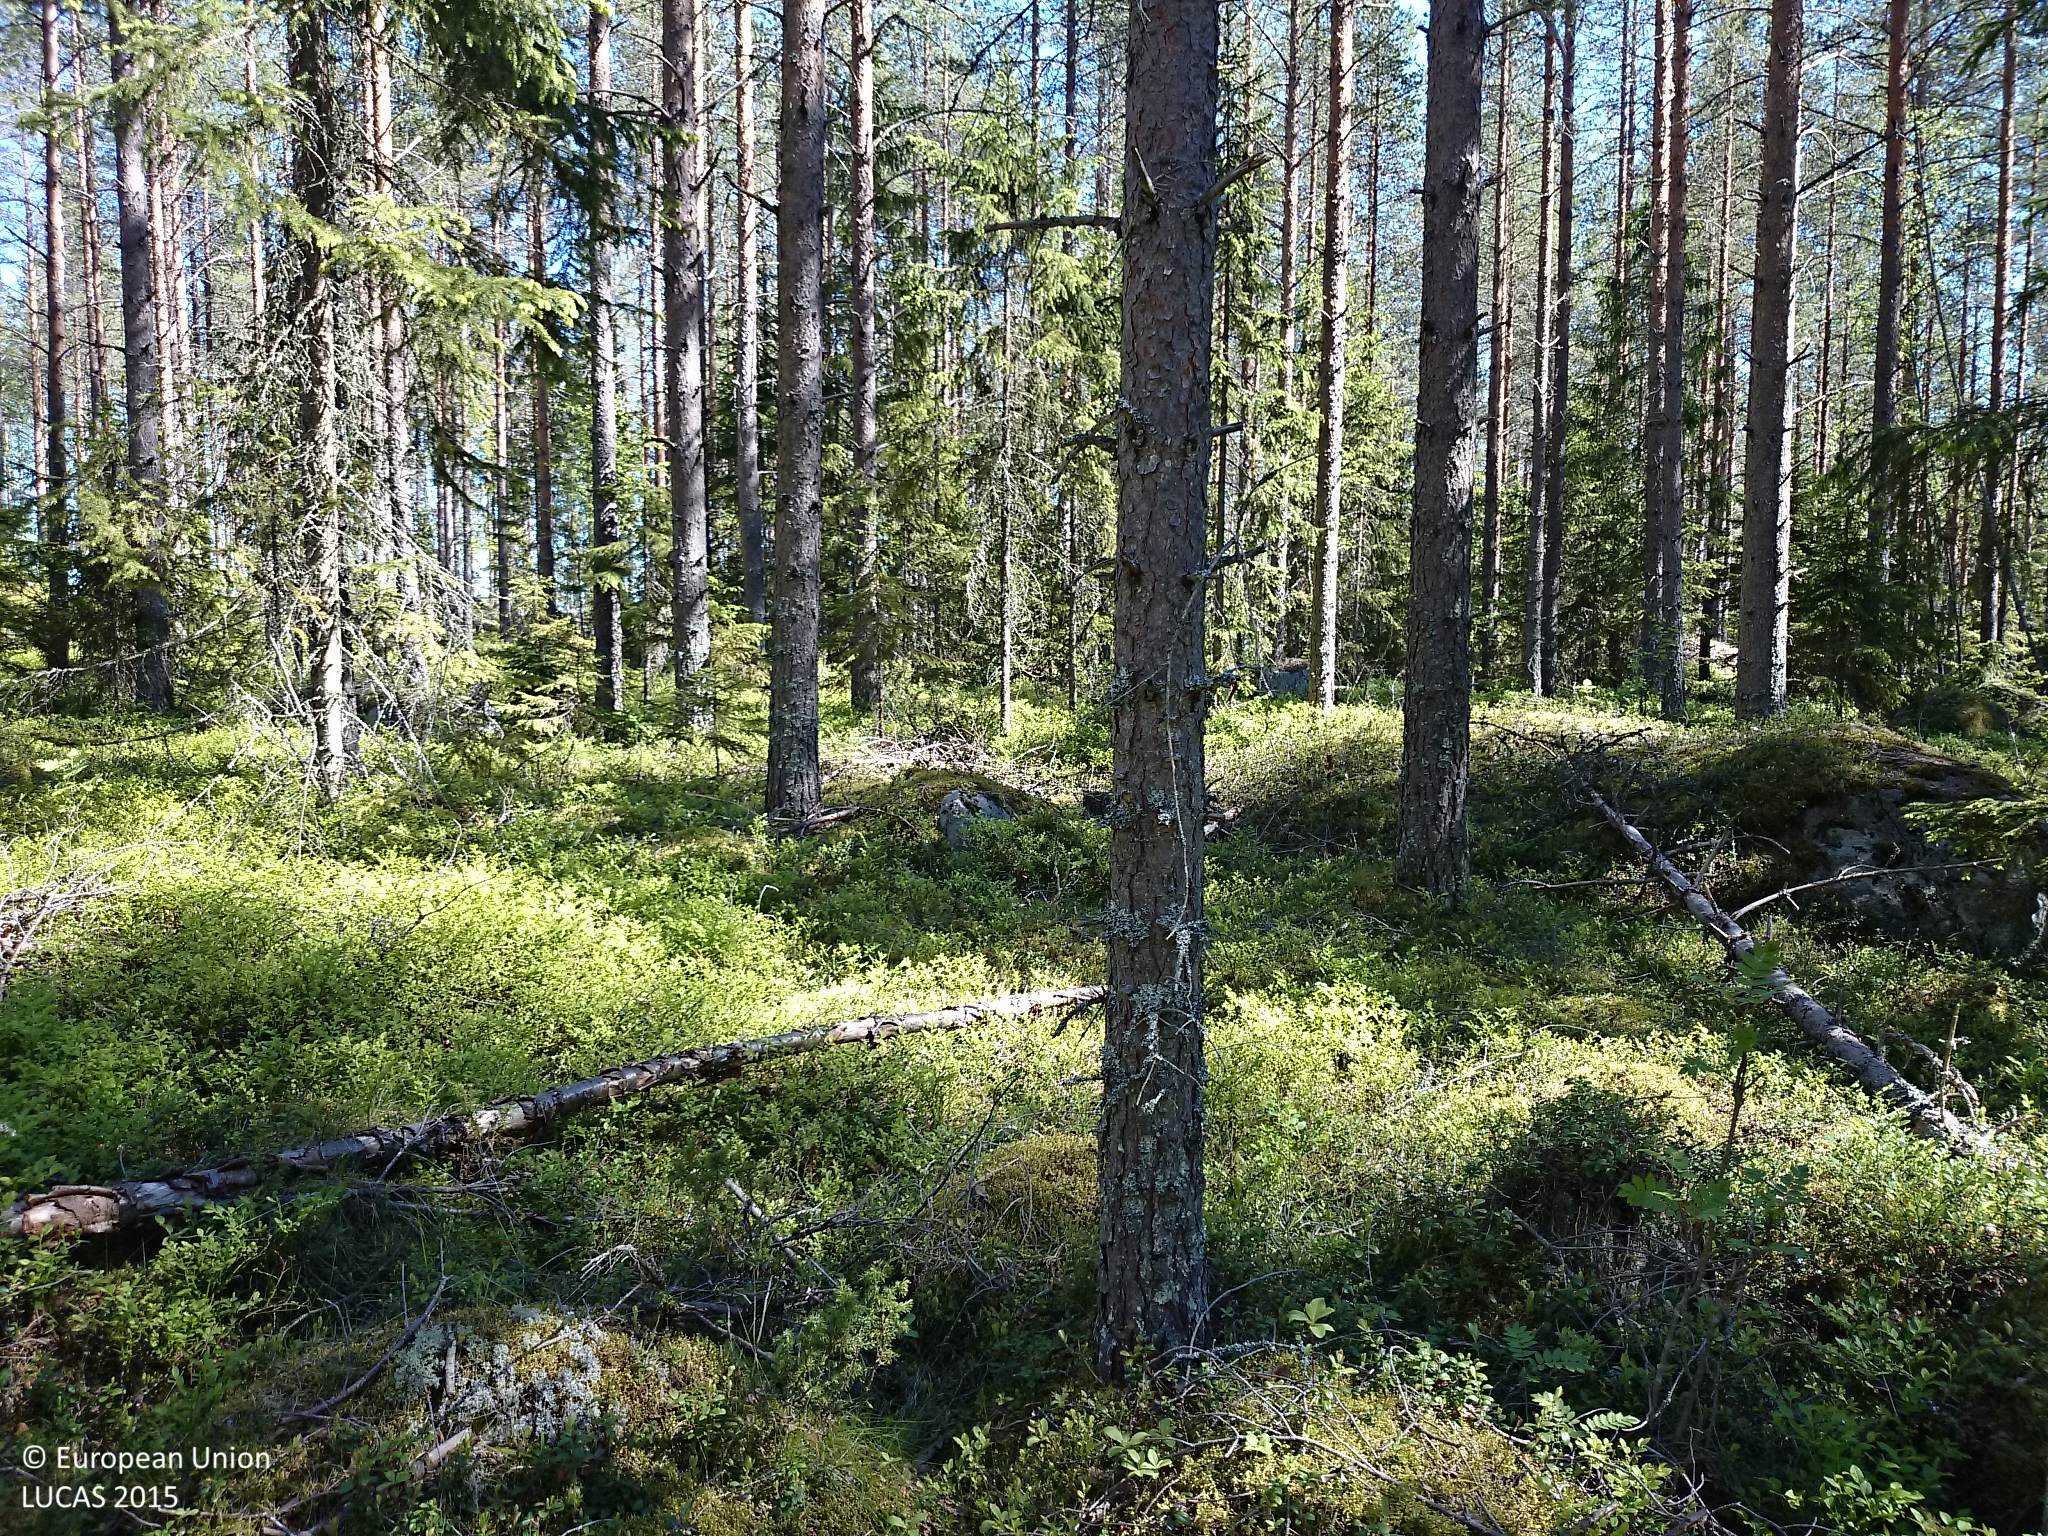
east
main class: Woodland
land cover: Pine dominated coniferous woodland
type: boreal forest
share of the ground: 50 - 75 %
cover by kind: coniferous forest trees 65 %, shrubs 35 %
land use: Forestry
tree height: > 5 m
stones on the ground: > 50 %
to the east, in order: Pine dominated coniferous woodland; Shrubland with sparse tree cover; Grassland without tree/shrub cover
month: June
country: SE
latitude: 63.9597
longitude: 20.7436
